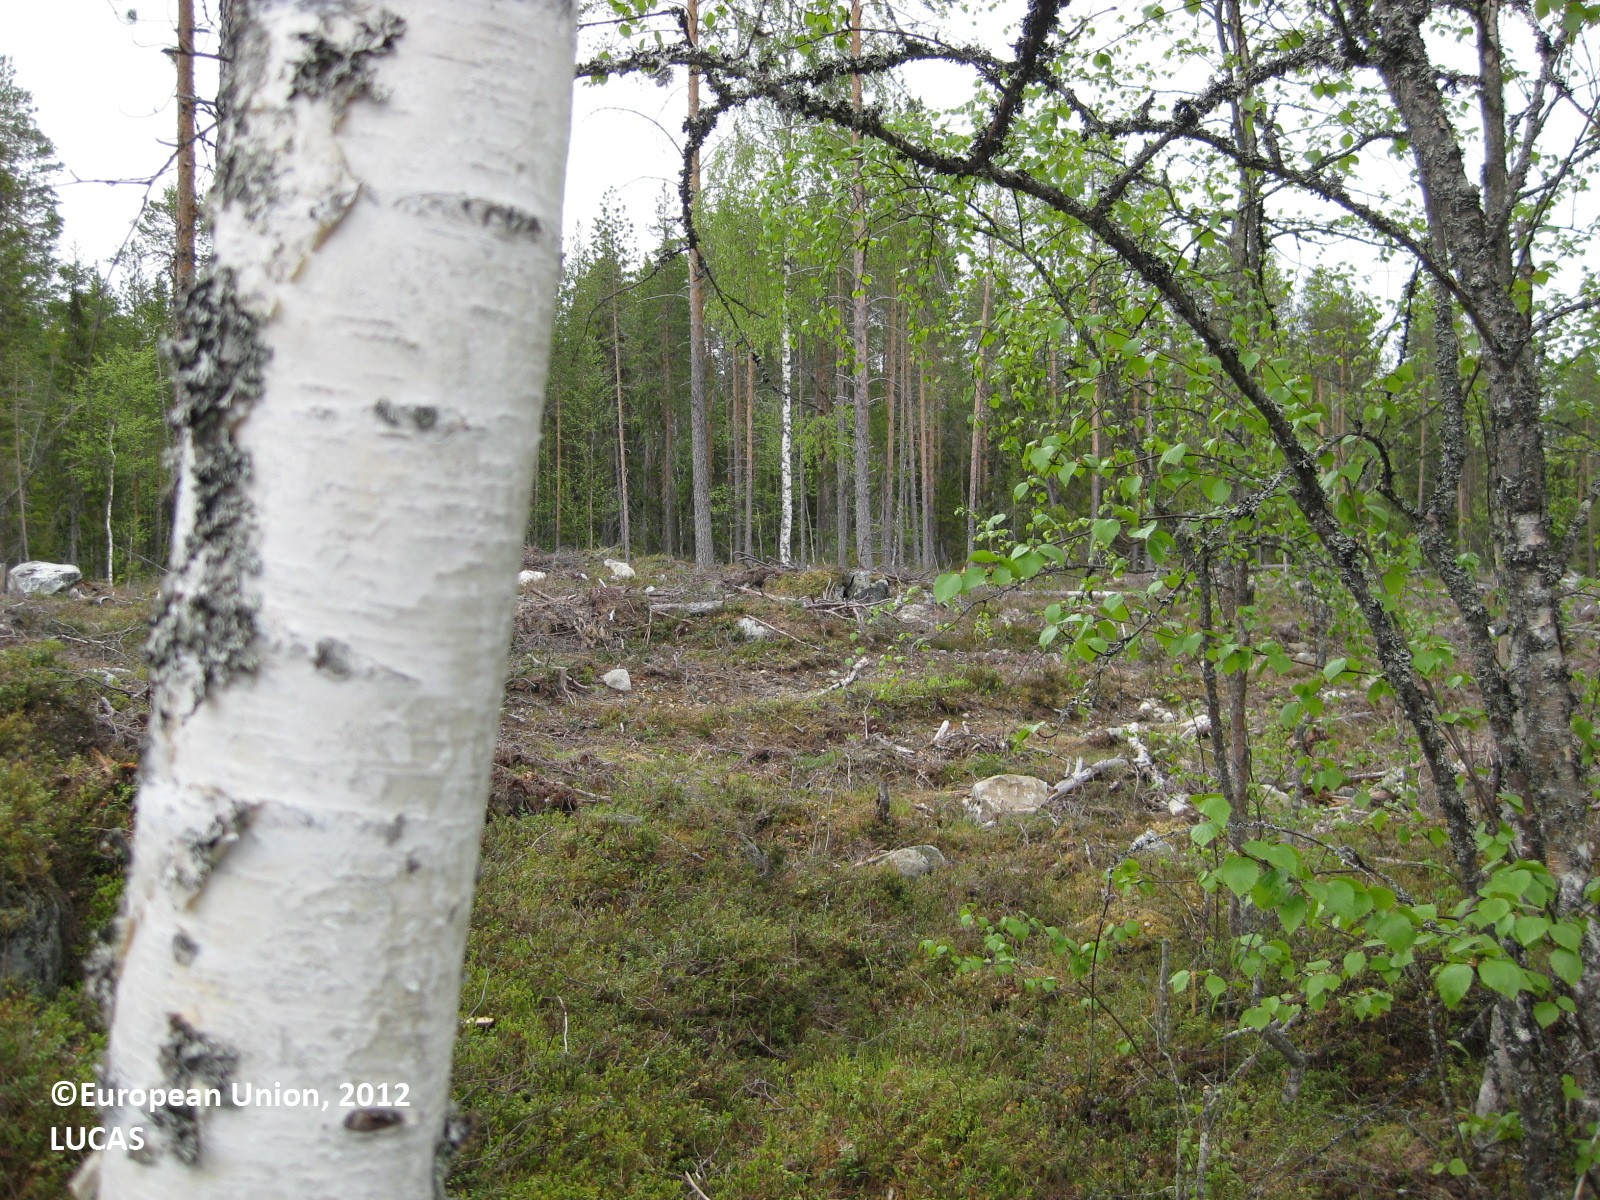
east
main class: Woodland
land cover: Pine dominated mixed woodland
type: boreal forest
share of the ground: 50 - 75 %
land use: Forestry
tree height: > 5 m
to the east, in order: Pine dominated mixed woodland; Shrubland with sparse tree cover; Pine dominated mixed woodland; Spruce dominated mixed woodland; Ditches and canals; Spruce dominated mixed woodland; Pine dominated coniferous woodland; Spruce dominated mixed woodland
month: June
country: FI
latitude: 65.2120
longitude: 29.1944
